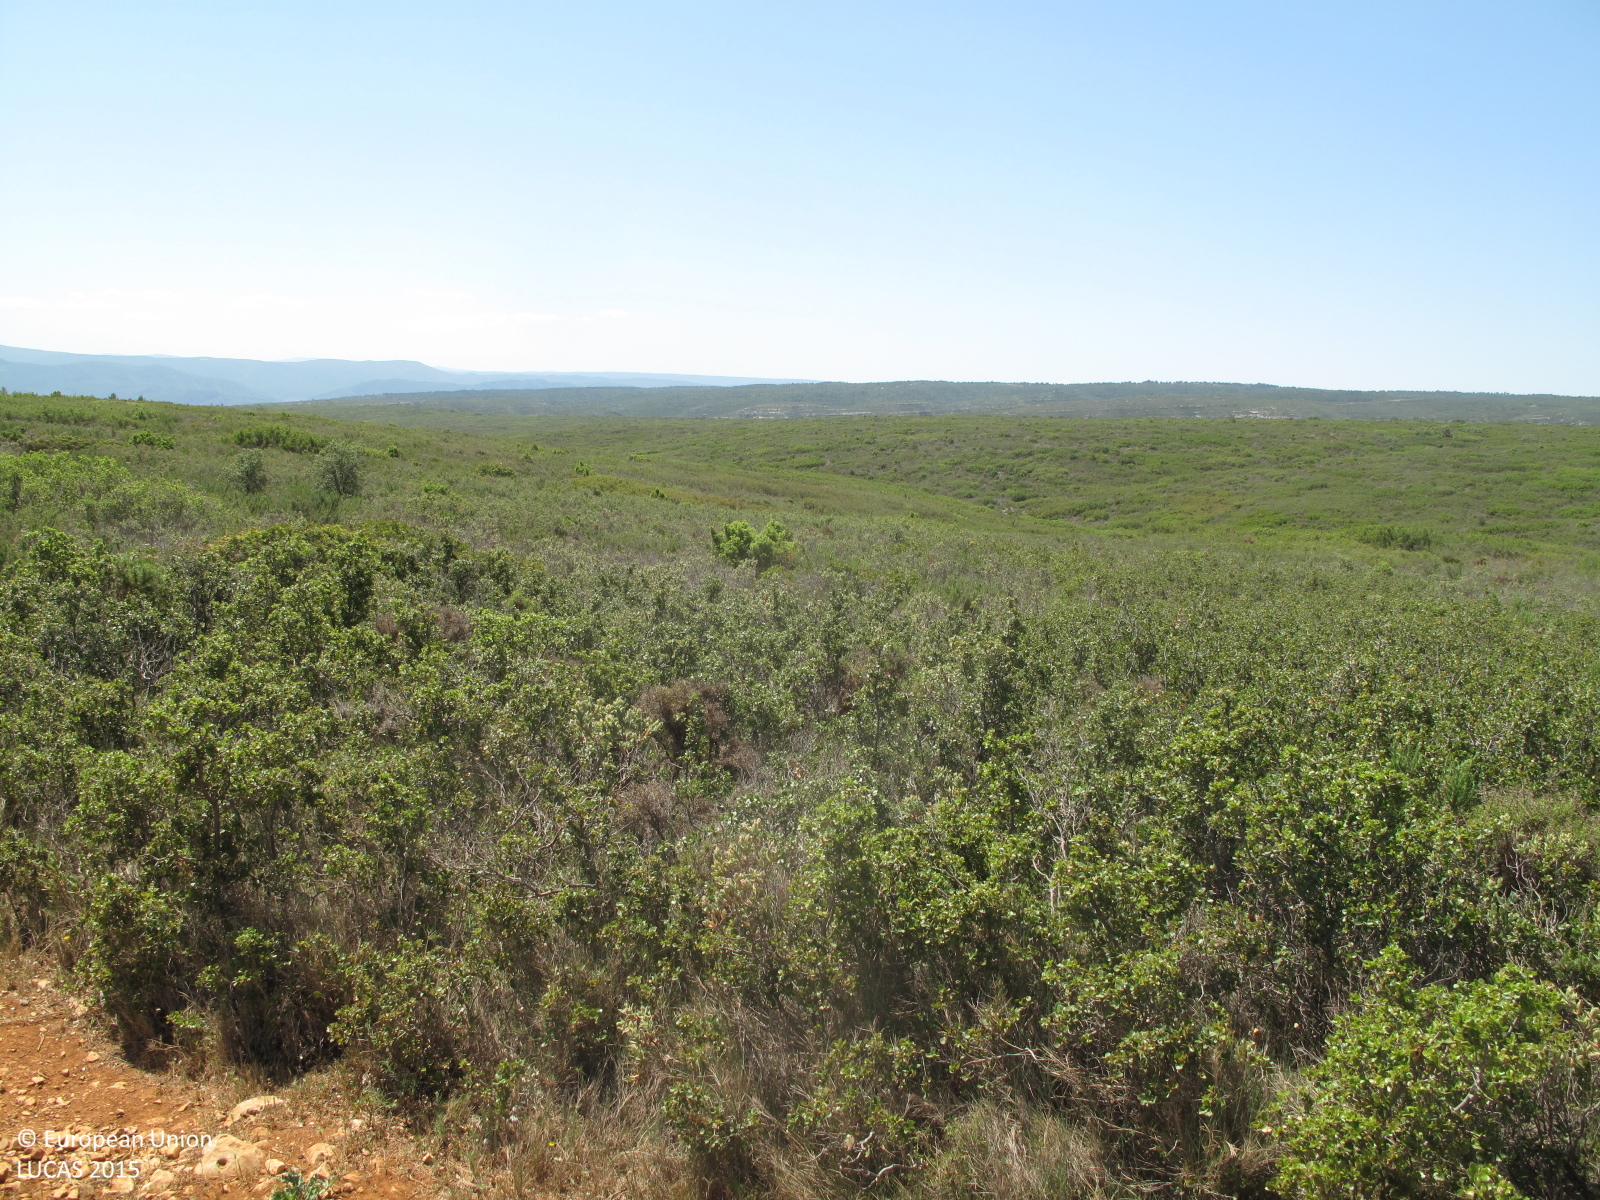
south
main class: Shrubland
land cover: Shrubland without tree cover
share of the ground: 50 - 75 %
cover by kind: shrubs 50 %, consolidated bare surface 30 %, herbaceous plants 20 %
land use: Semi-natural and natural areas not in use
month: May
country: ES
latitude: 38.9416
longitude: -0.7807
